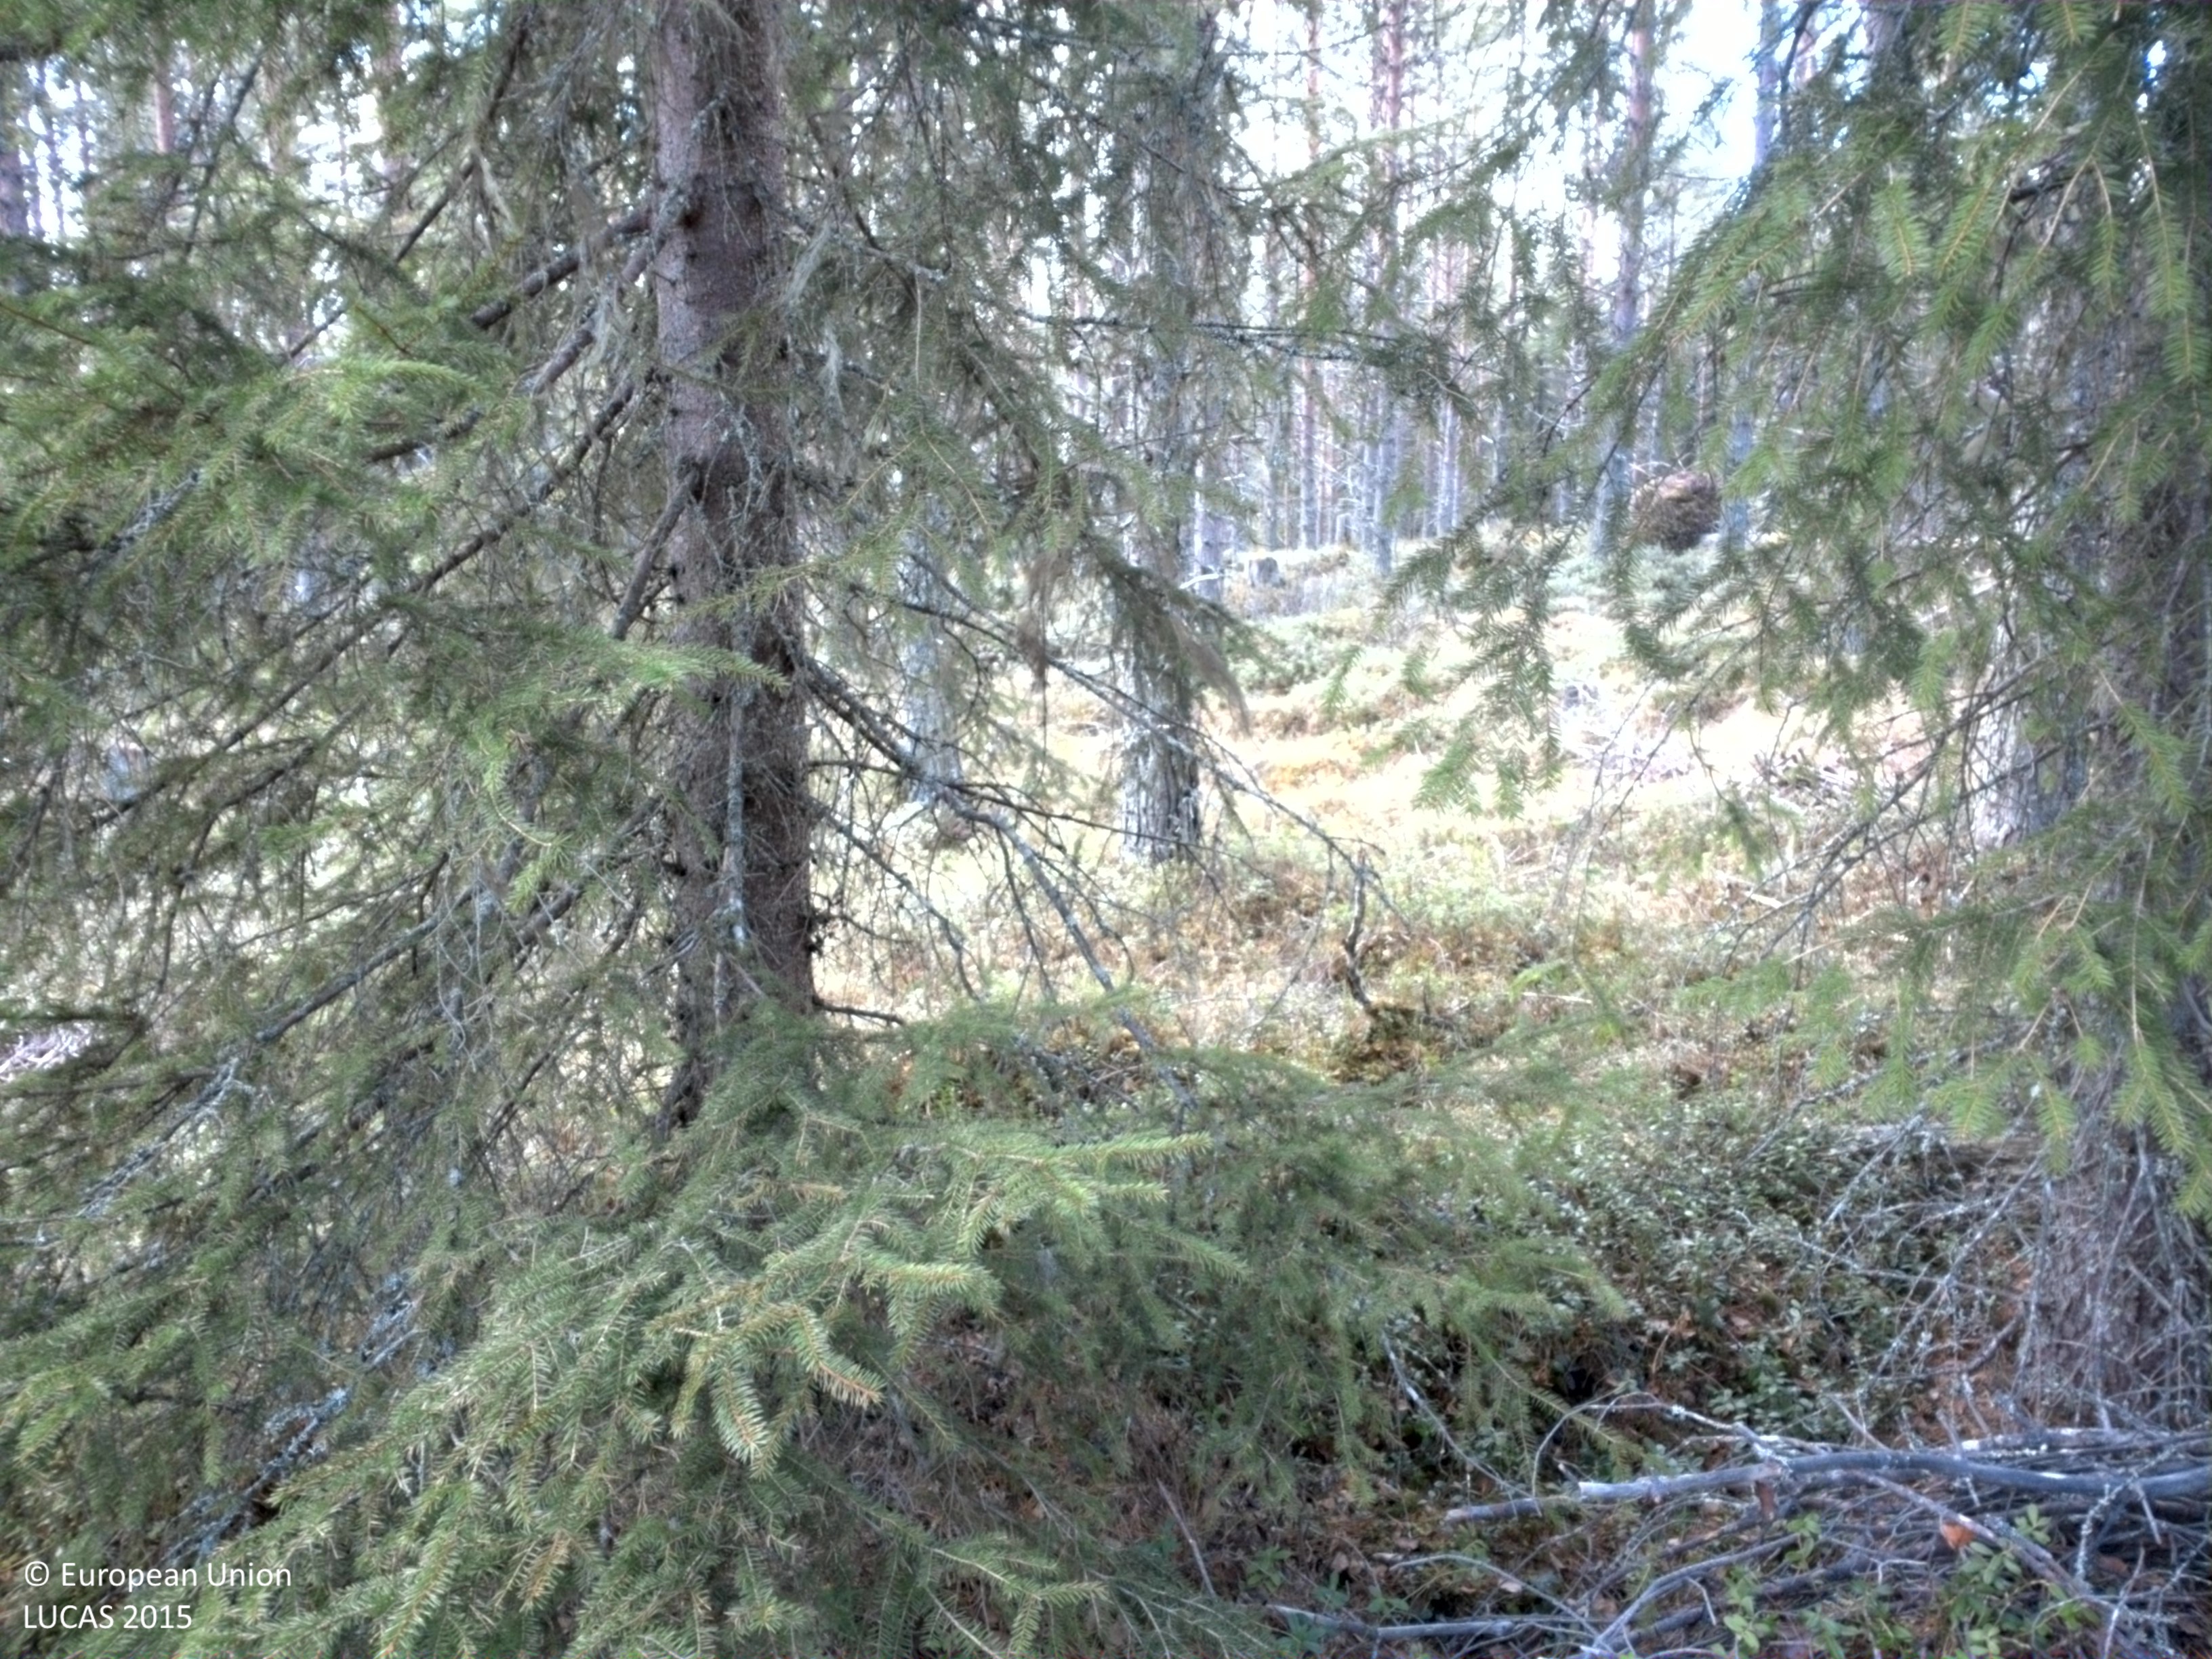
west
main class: Woodland
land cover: Pine dominated coniferous woodland
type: boreal forest
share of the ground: 50 - 75 %
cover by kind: coniferous forest trees 60 %, herbaceous plants 30 %, broadleaved forest trees 5 %, lichens and mosses 5 %
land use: Forestry
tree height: > 5 m
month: May
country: SE
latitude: 64.2631
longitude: 17.7503
